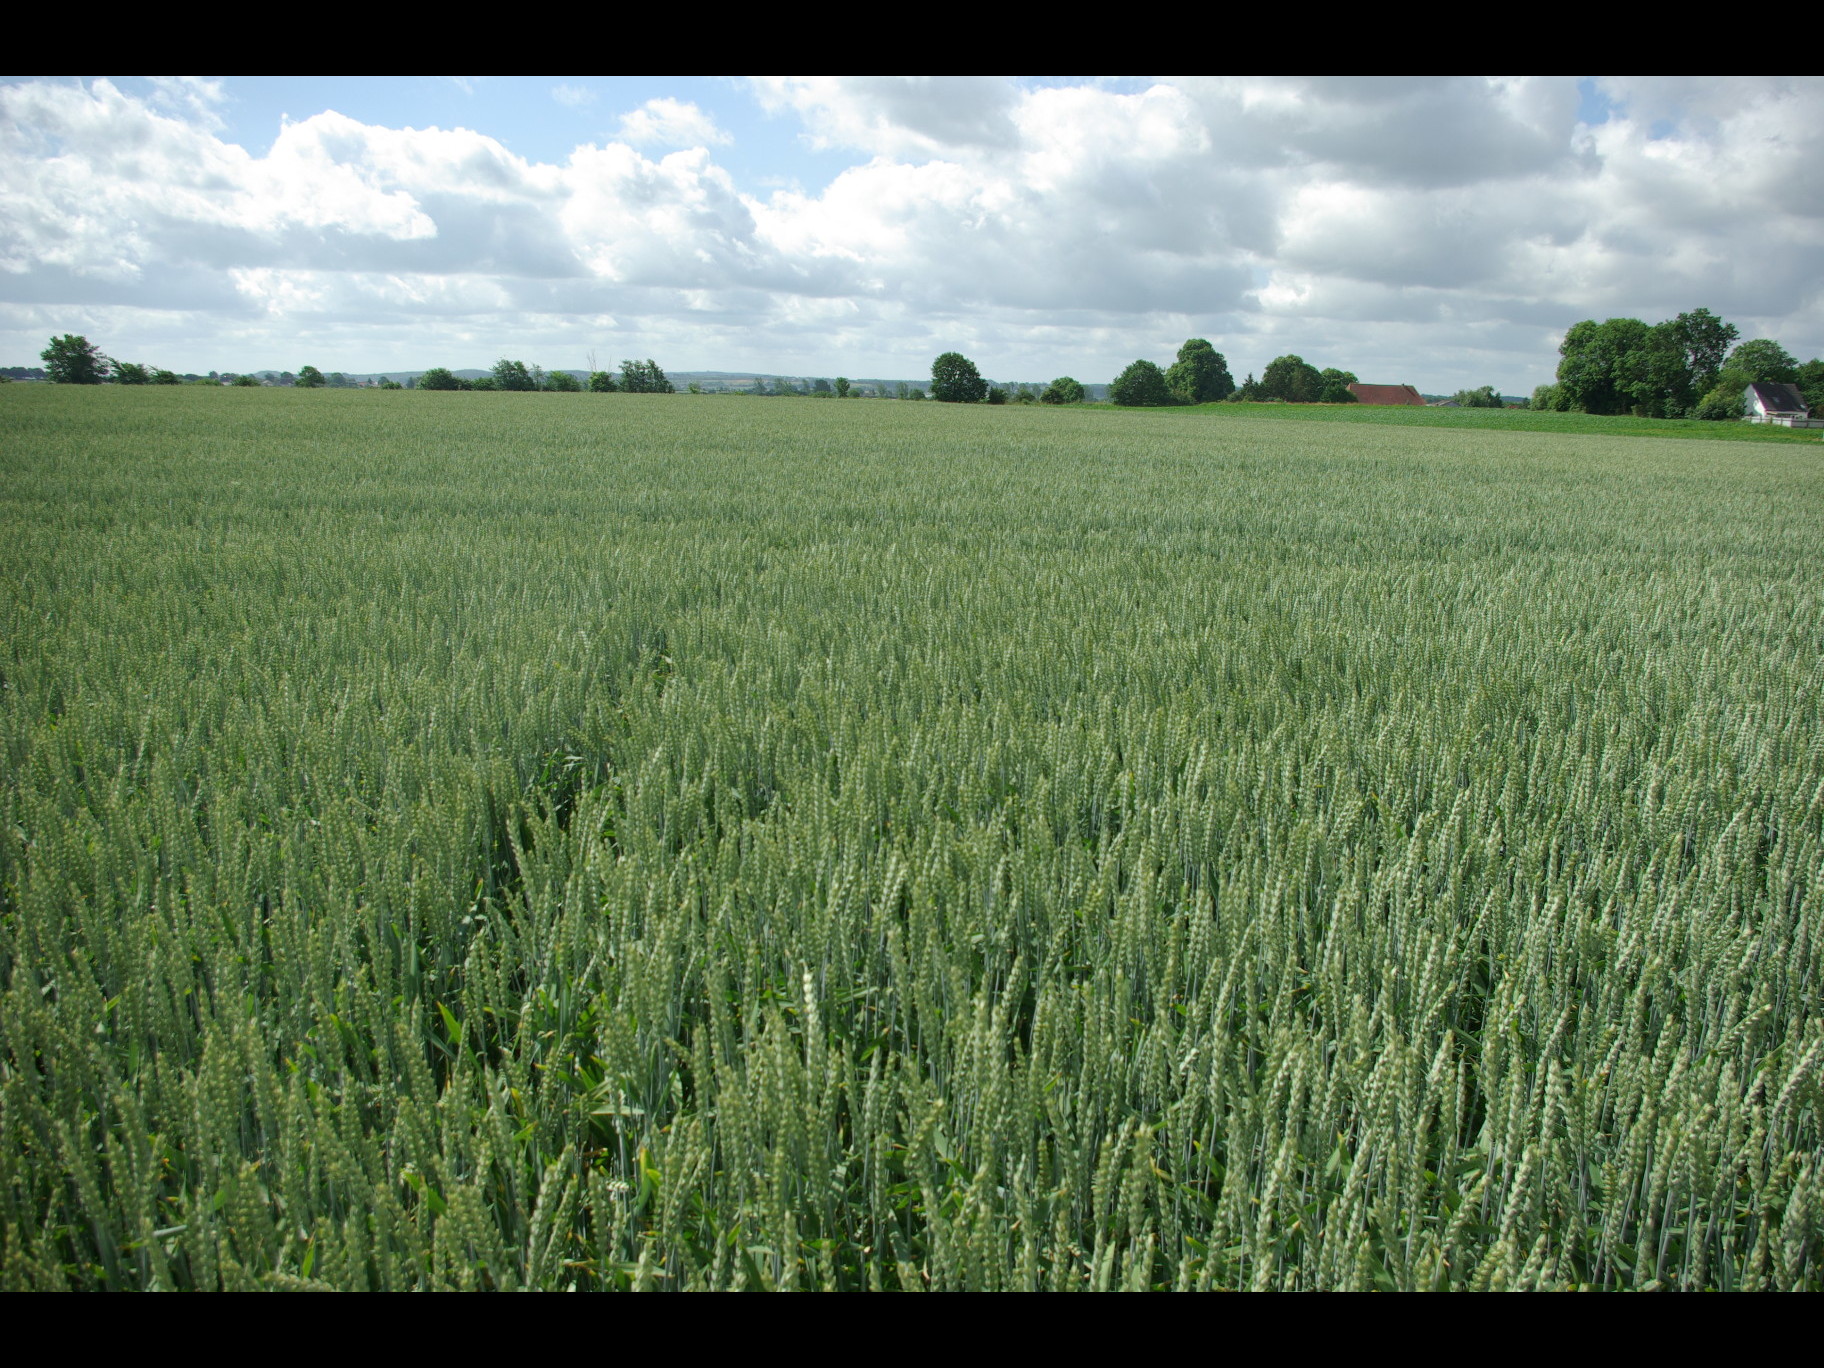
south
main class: Cropland
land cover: Common wheat
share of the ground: > 75 %
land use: Agriculture (excluding fallow land and kitchen gardens)
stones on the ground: 25 - 50 %
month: July
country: DE
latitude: 54.5516
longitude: 9.6446
